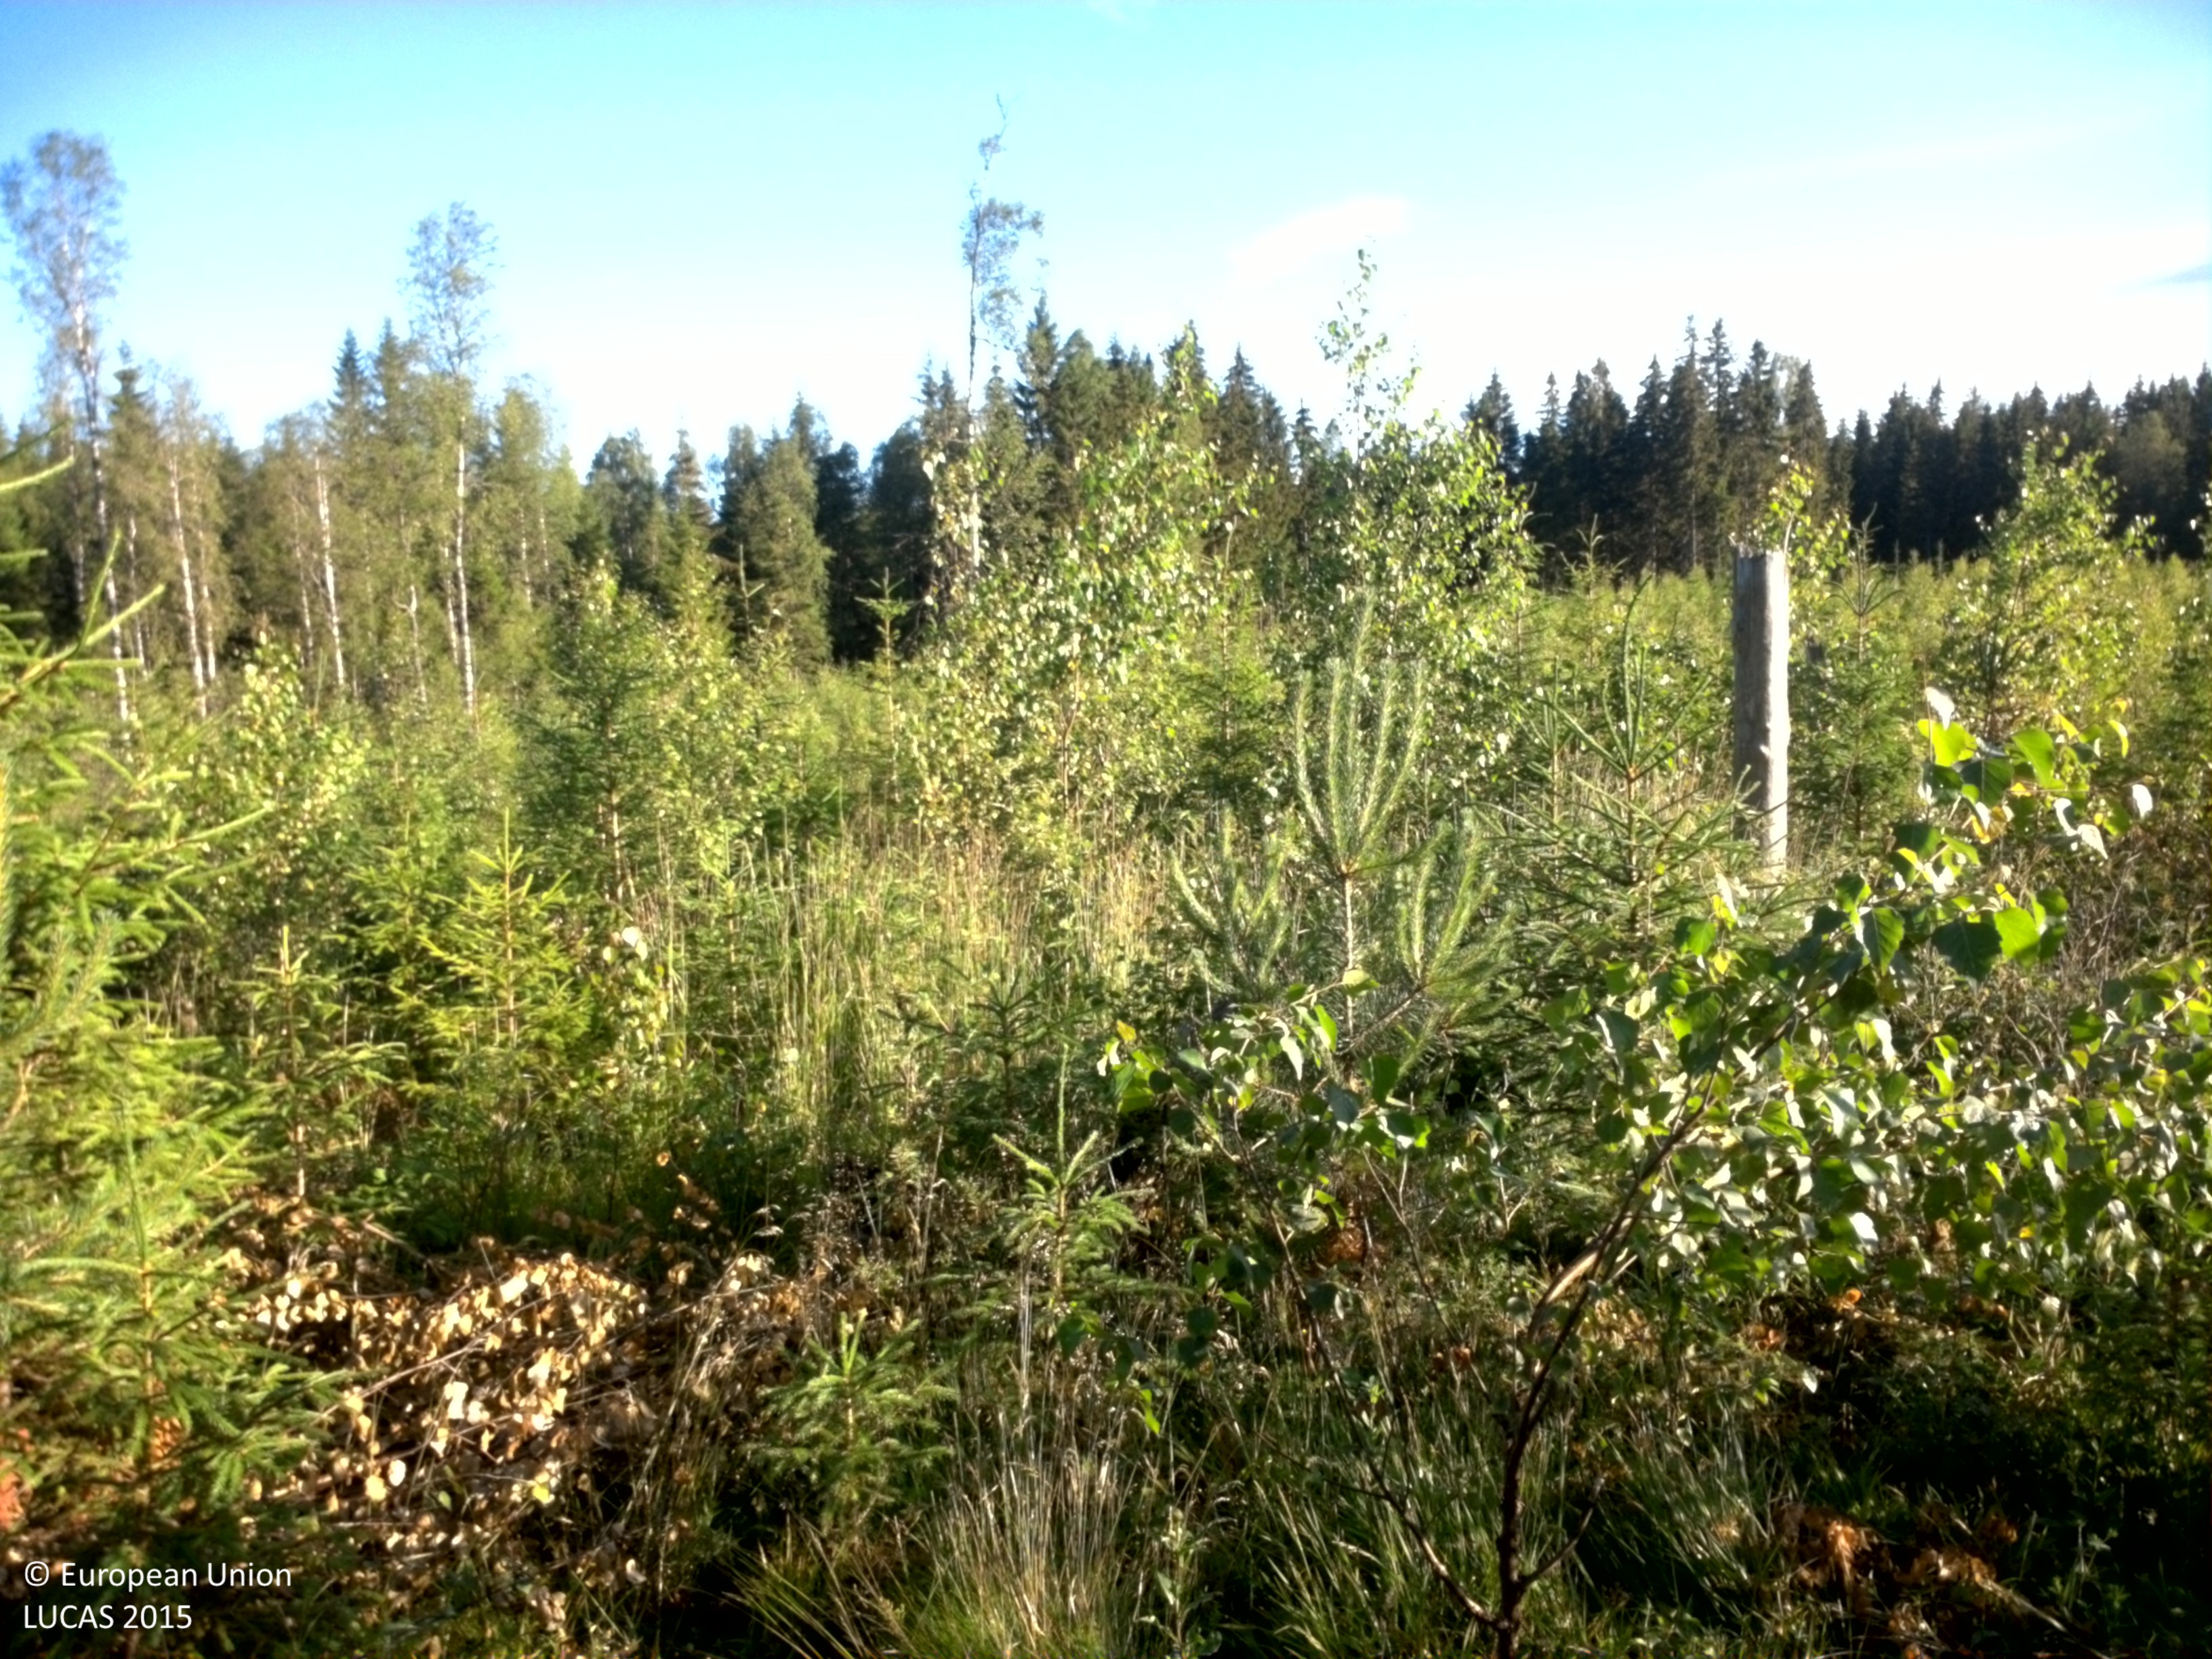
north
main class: Woodland
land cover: Spruce dominated mixed woodland
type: boreal forest
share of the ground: 25 - 50 %
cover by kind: coniferous forest trees 35 %, herbaceous plants 30 %, broadleaved forest trees 15 %, shrubs 5 %
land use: Forestry
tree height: < 5 m
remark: Clear cut
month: July
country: SE
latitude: 59.8720
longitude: 12.4046
